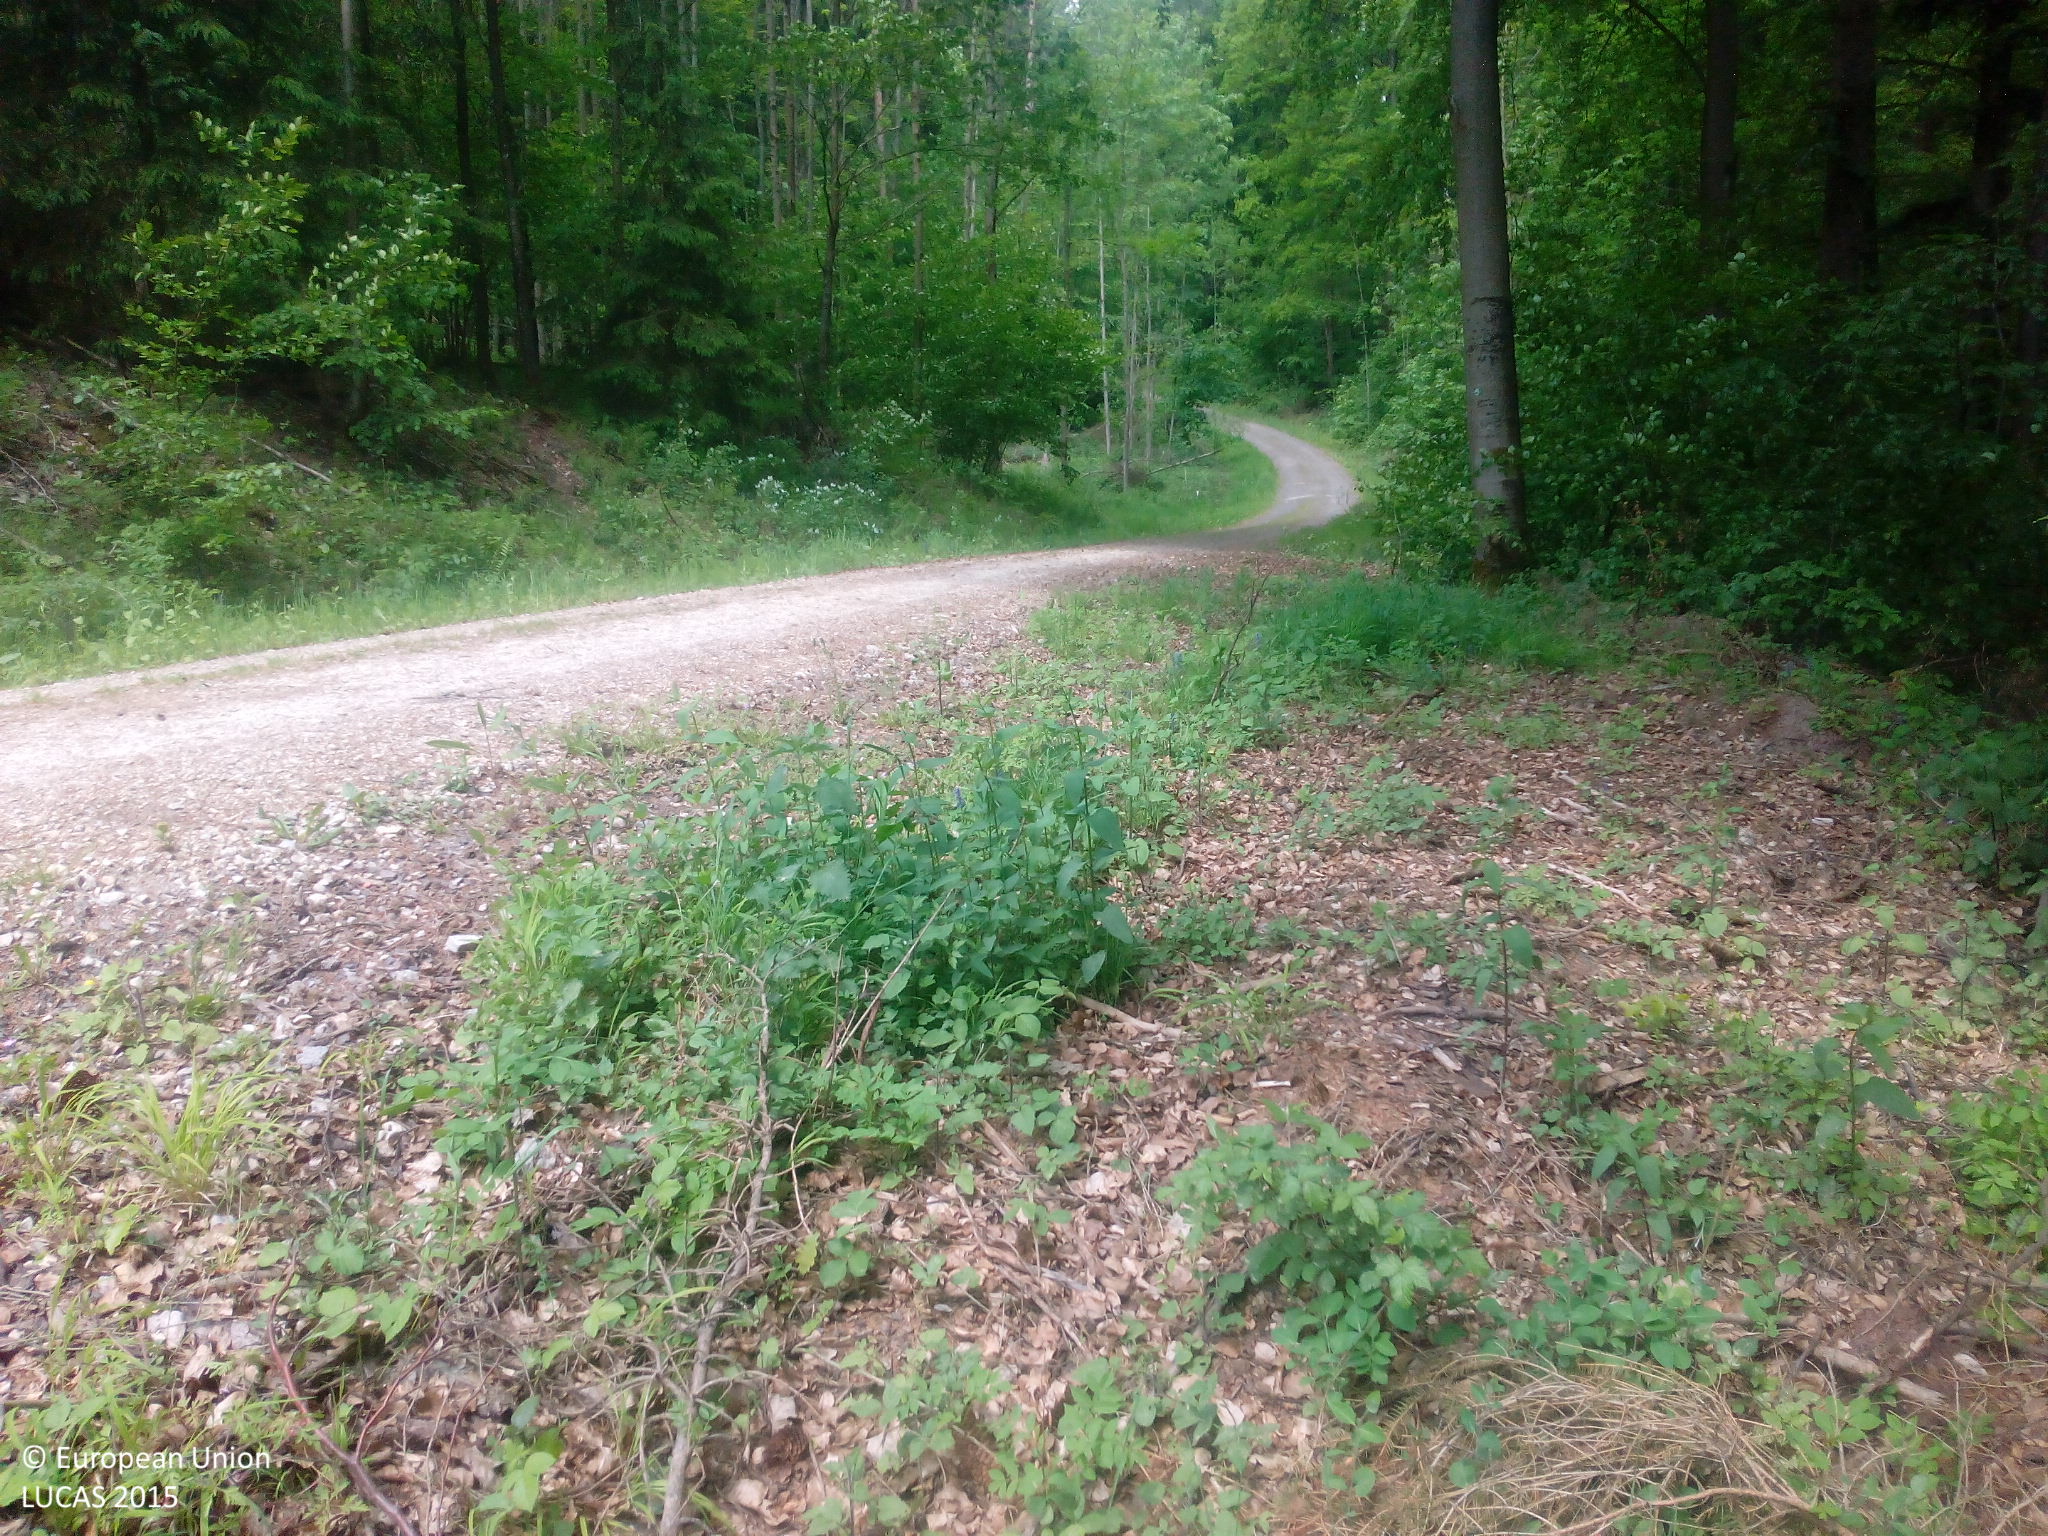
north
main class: Woodland
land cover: Spruce dominated mixed woodland
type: hemiboreal forest and nemoral coniferous forest and mixed broadleaved-coniferous forest
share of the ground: > 75 %
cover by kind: broadleaved forest trees 70 %, coniferous forest trees 30 %
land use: Forestry
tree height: > 5 m
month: May
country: DE
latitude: 50.2163
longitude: 10.9387
